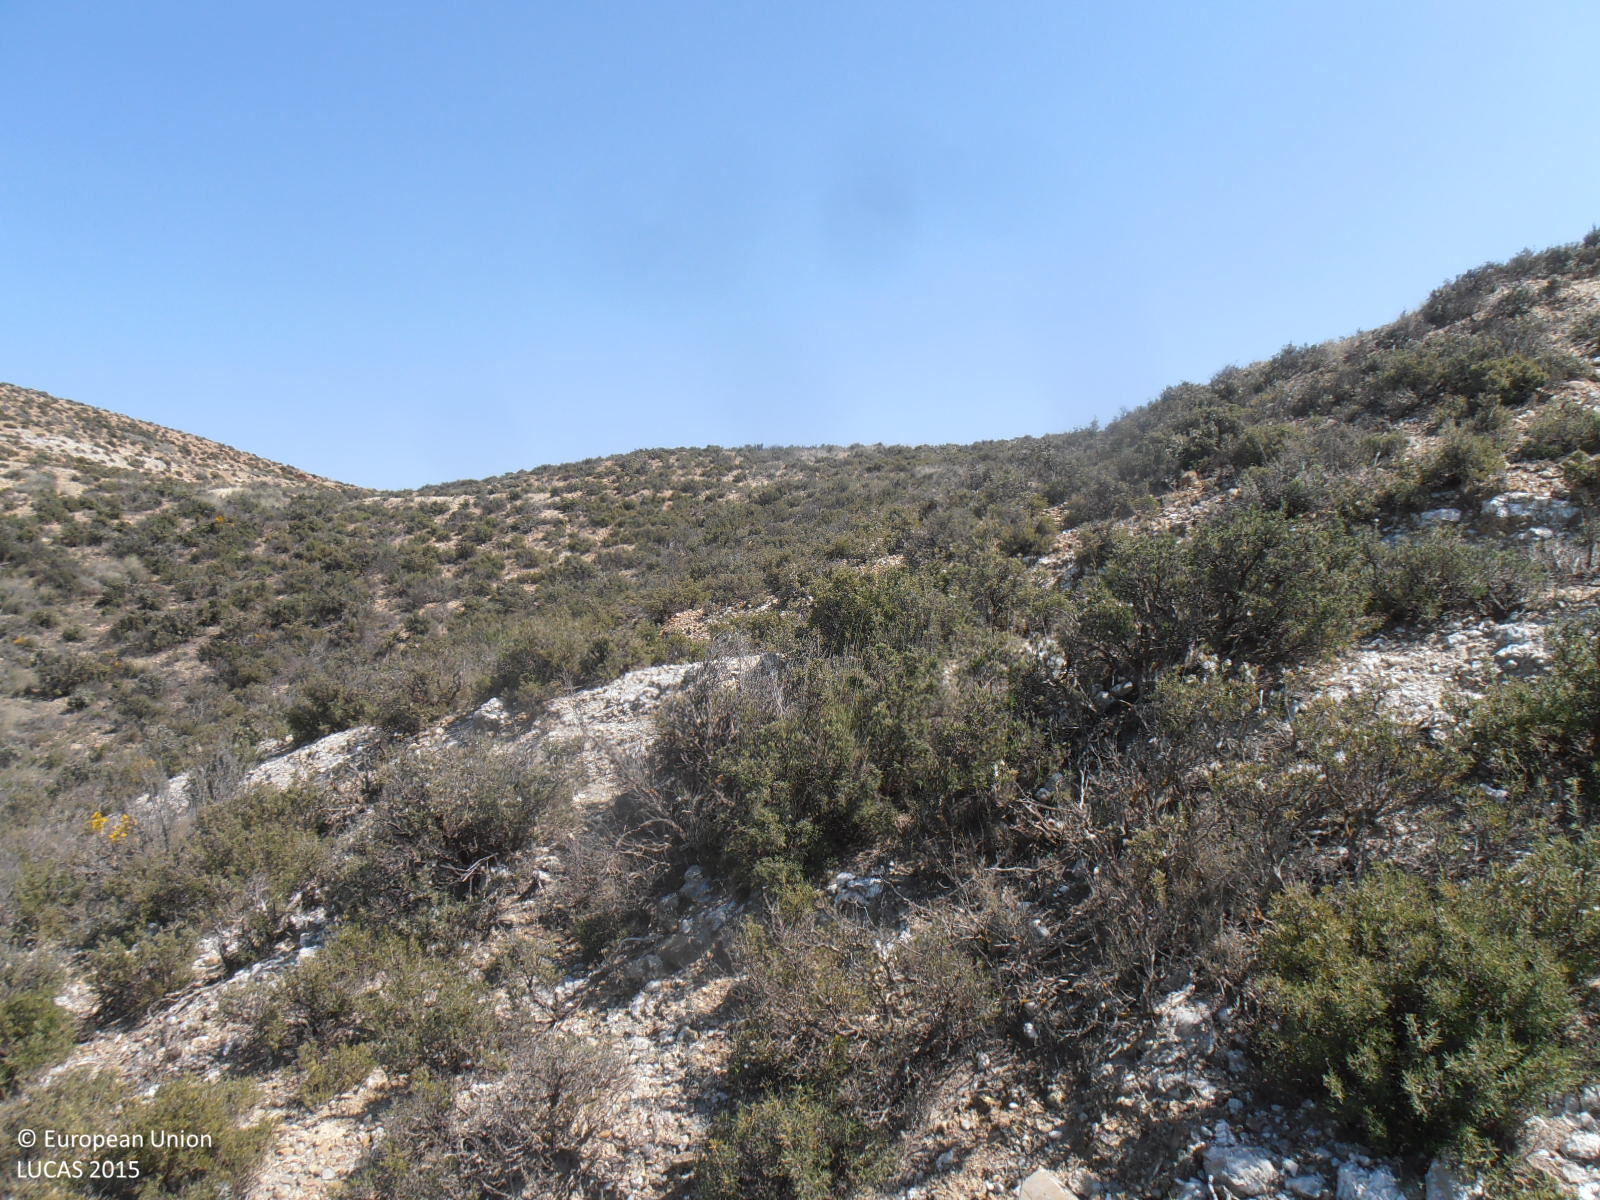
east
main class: Shrubland
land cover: Shrubland without tree cover
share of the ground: > 75 %
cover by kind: shrubs 60 %, consolidated bare surface 40 %
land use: Semi-natural and natural areas not in use
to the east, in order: Shrubland without tree cover
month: April
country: ES
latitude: 41.6029
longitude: -0.9525
